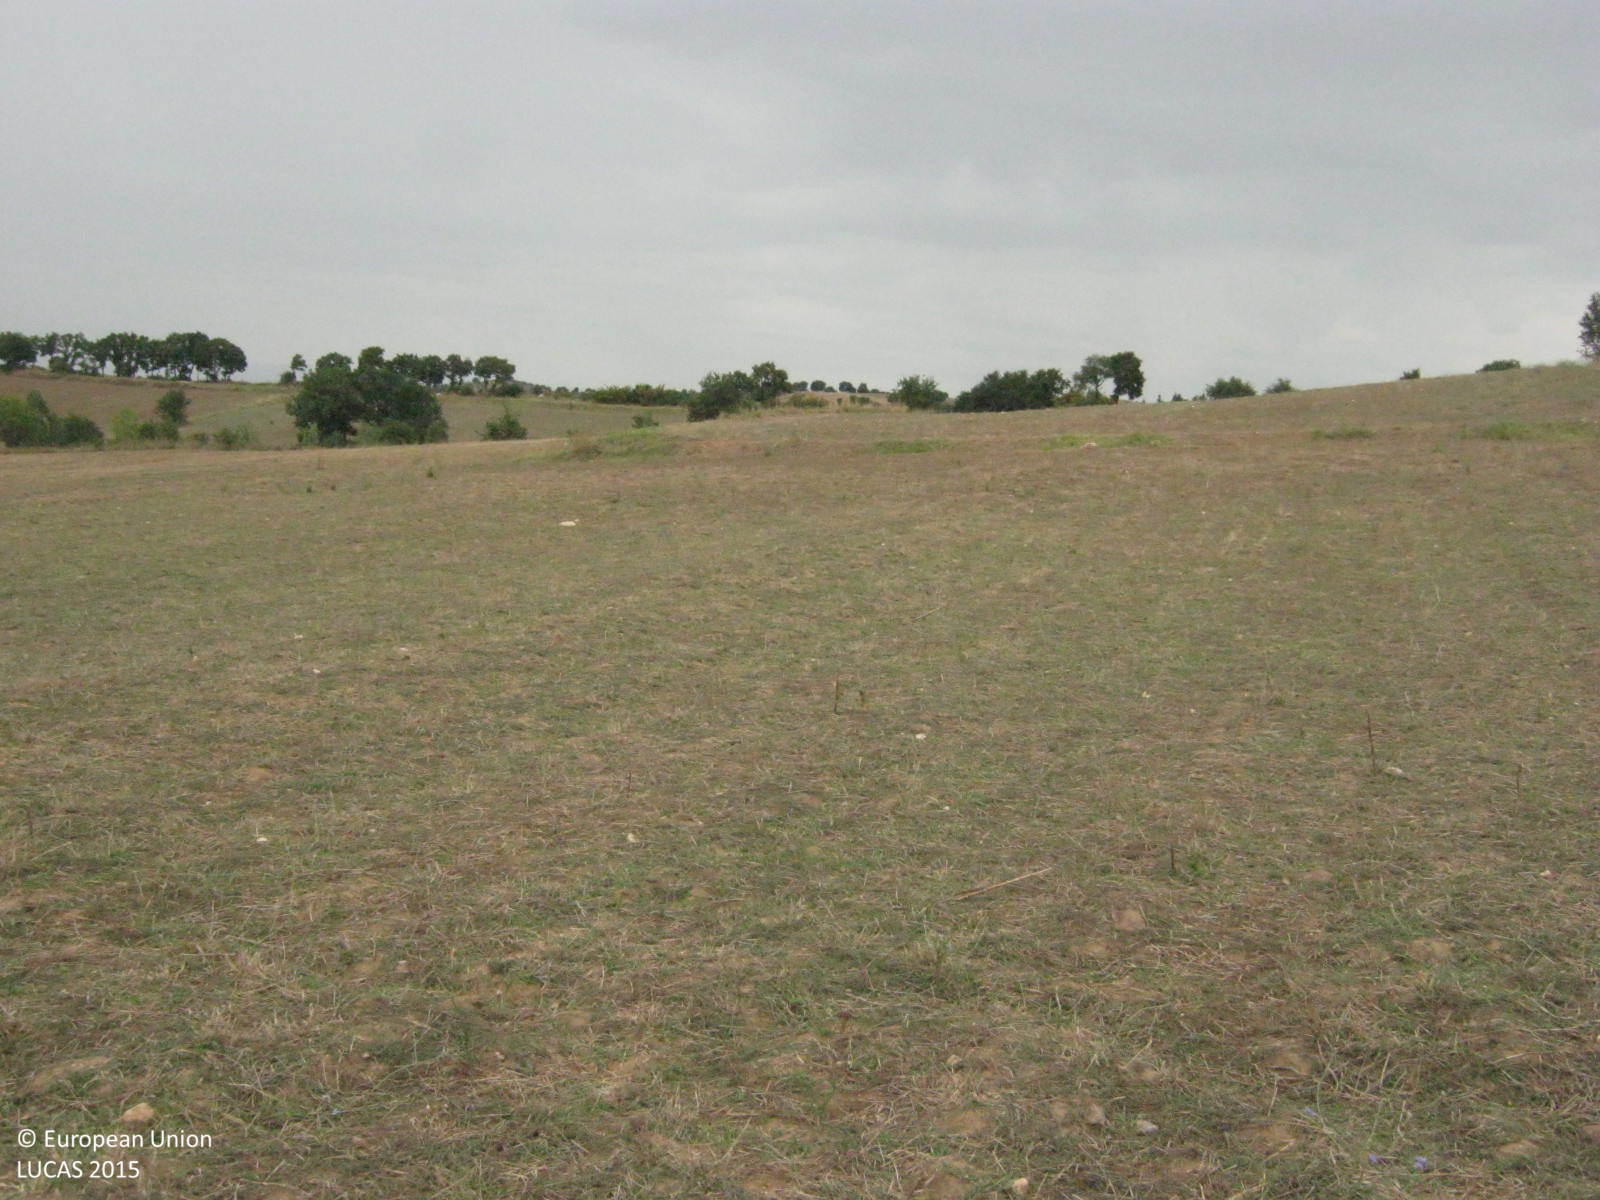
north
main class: Grassland
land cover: Spontaneously vegetated surfaces
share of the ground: > 75 %
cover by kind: herbaceous plants 90 %, consolidated bare surface 10 %
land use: Agriculture (excluding fallow land and kitchen gardens)
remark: Harvested field
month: August
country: GR
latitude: 40.9004
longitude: 22.9853
